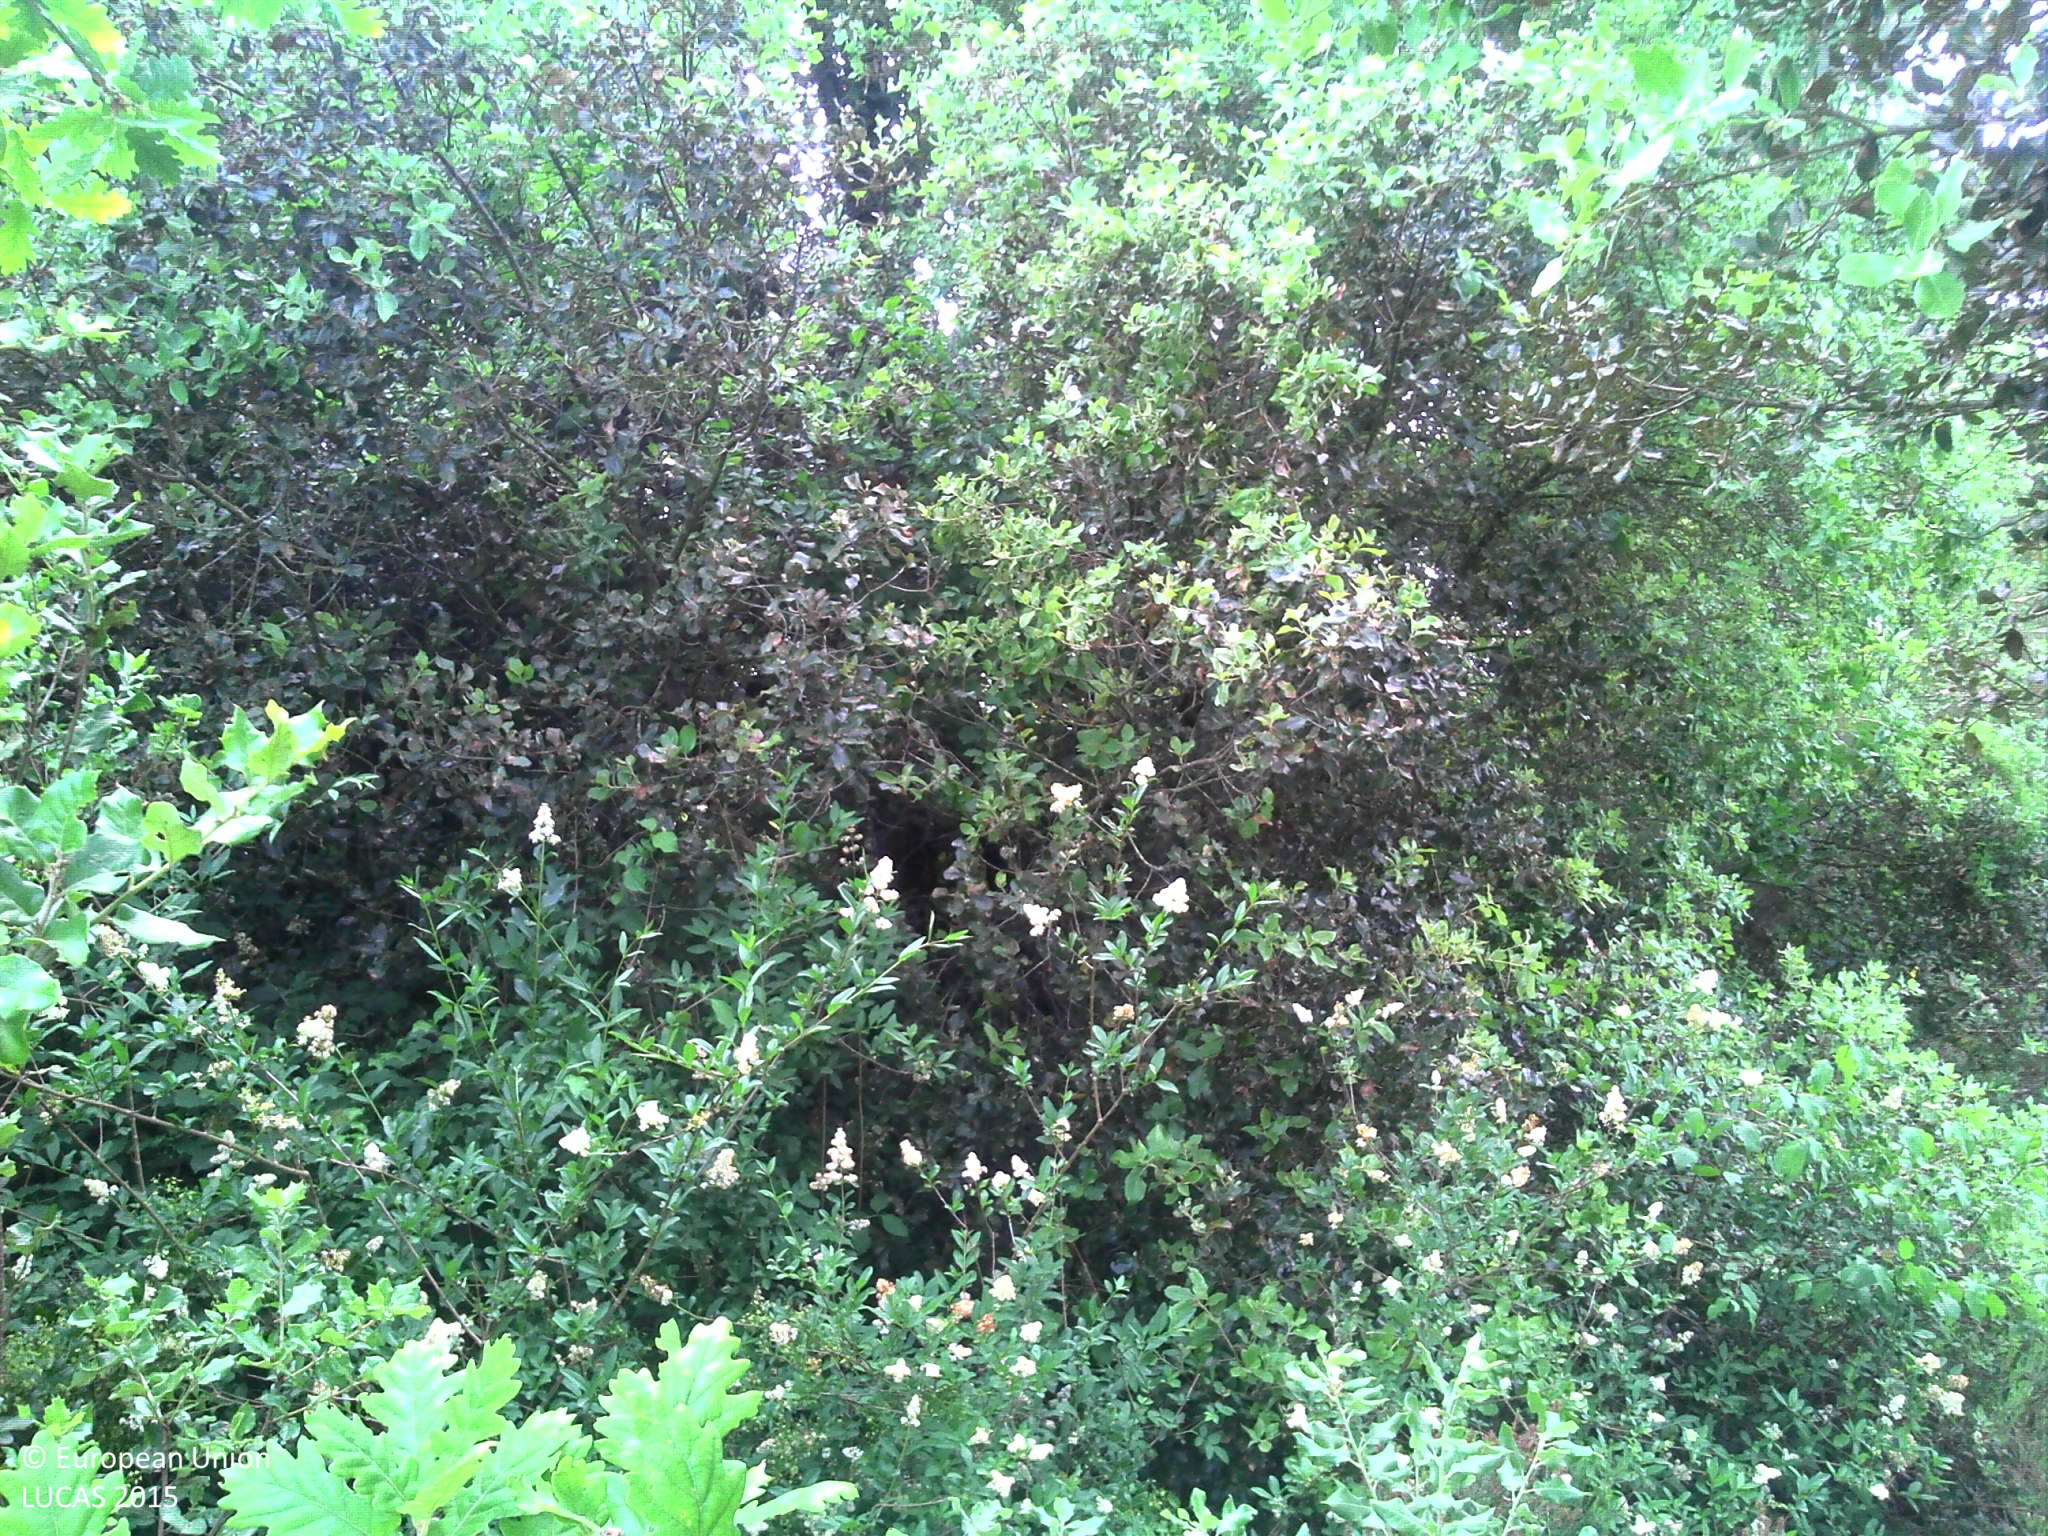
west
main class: Woodland
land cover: Broadleaved woodland
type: beech forest
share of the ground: 25 - 50 %
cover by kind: broadleaved forest trees 100 %
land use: Forestry
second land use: Amenities, museums, leisure
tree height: > 5 m
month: June
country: FR
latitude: 45.9000
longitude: -0.7370
